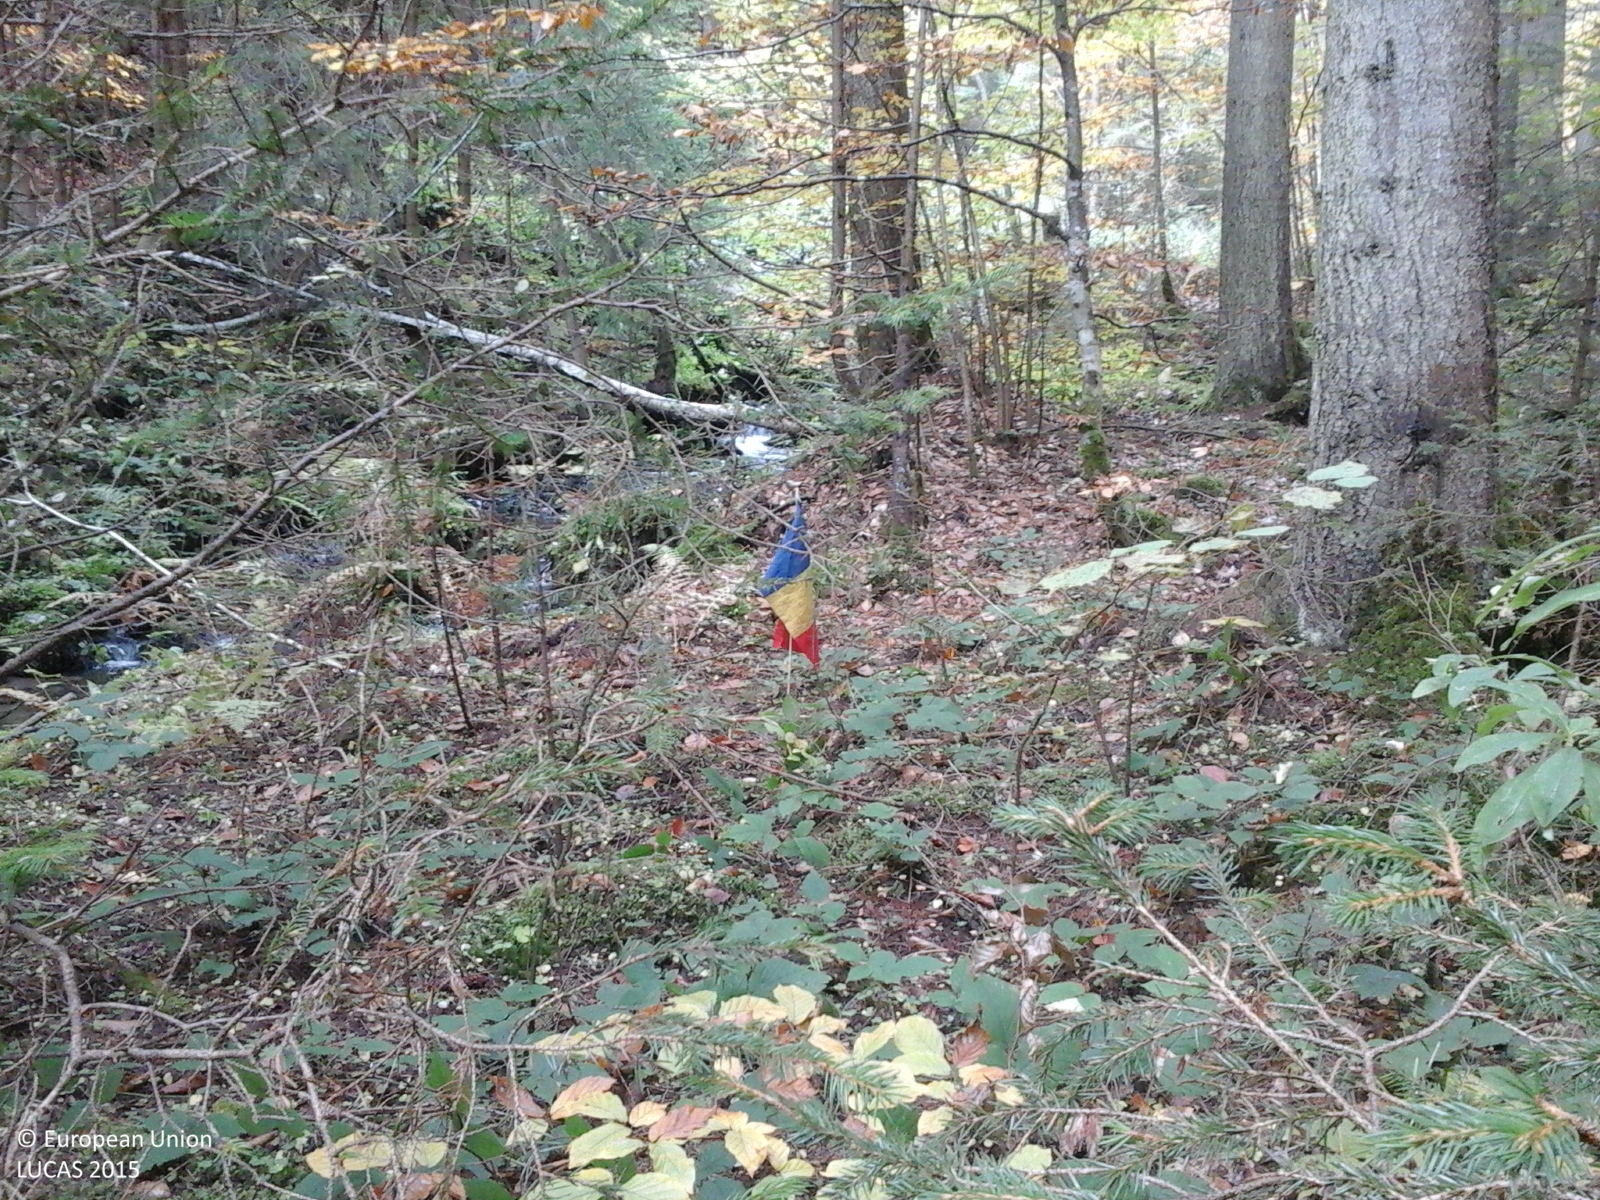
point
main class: Woodland
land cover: Spruce dominated mixed woodland
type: alpine coniferous forest
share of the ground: > 75 %
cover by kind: coniferous forest trees 60 %, broadleaved forest trees 40 %
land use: Forestry
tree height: > 5 m
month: October
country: RO
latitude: 46.5562
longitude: 25.4608
